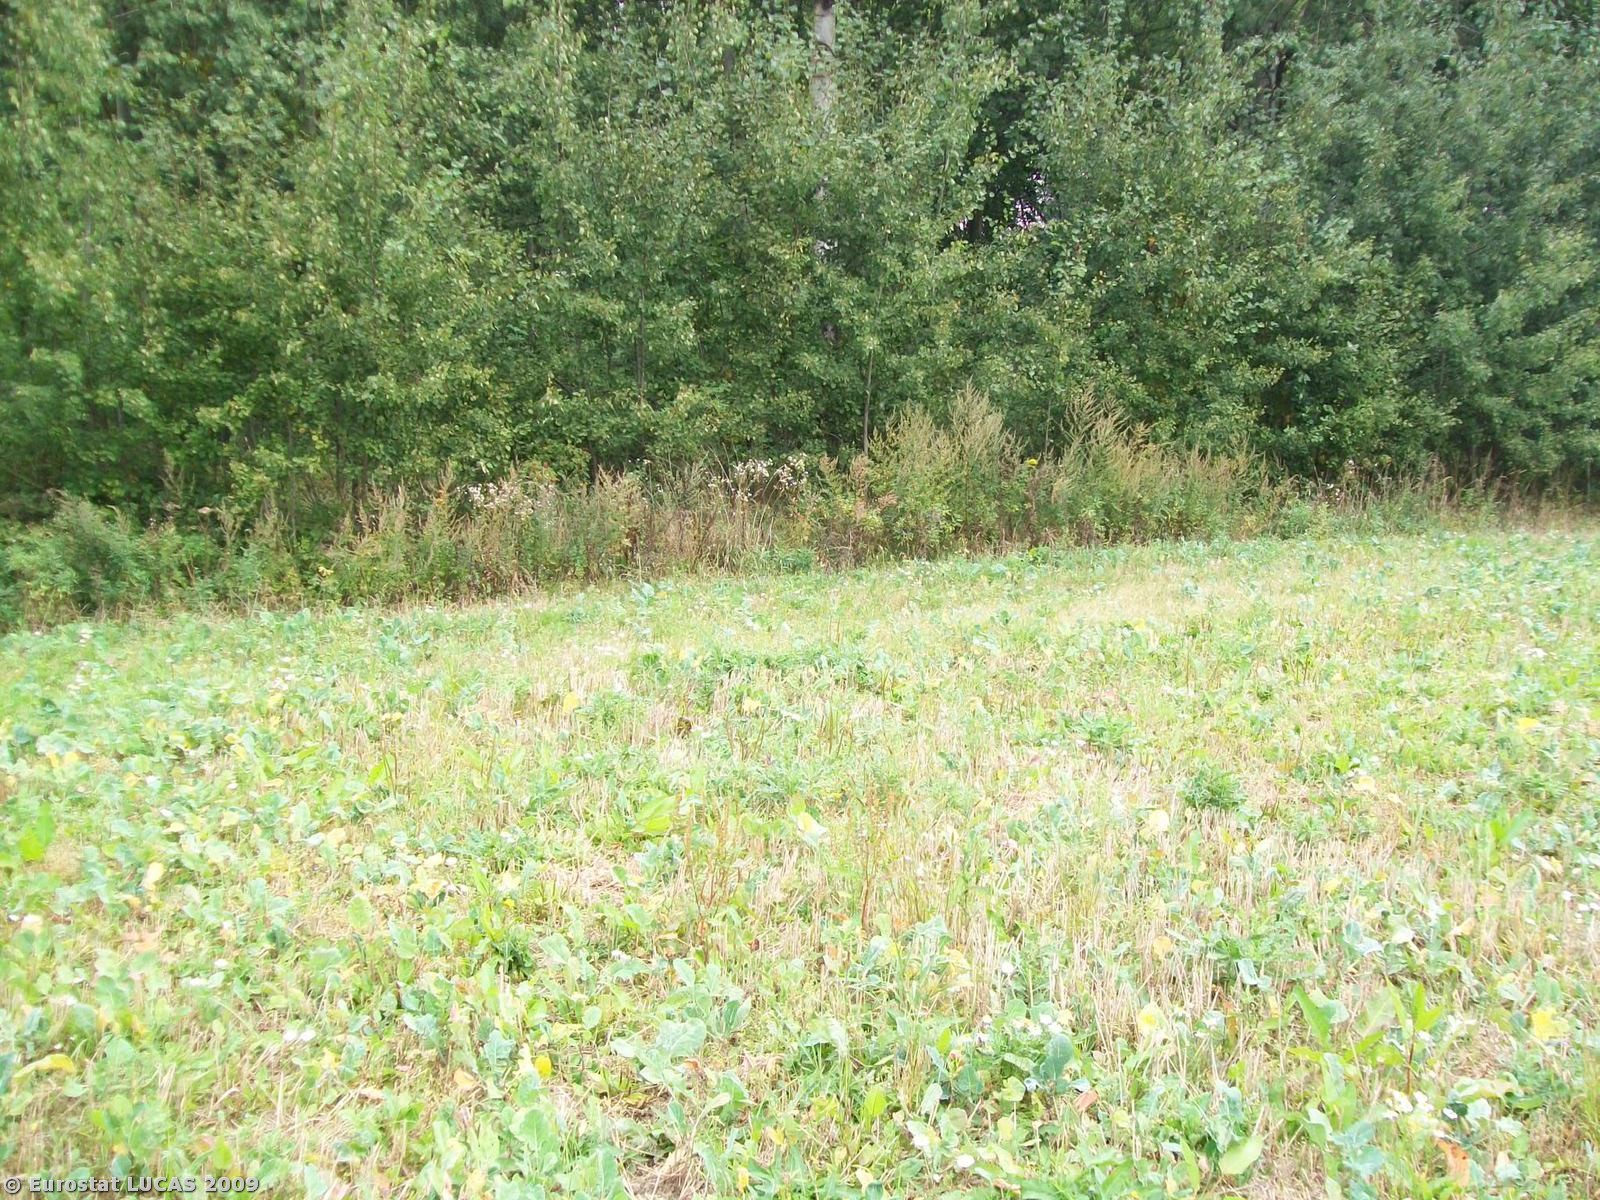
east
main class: Cropland
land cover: Barley
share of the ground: < 10 %
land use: Agriculture (excluding fallow land and kitchen gardens)
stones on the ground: < 10 %
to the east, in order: Barley; Tracks; Broadleaved woodland; Inland running water; Lines of trees; Grassland without tree/shrub cover
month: September
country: PL
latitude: 50.4382
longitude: 17.2908
